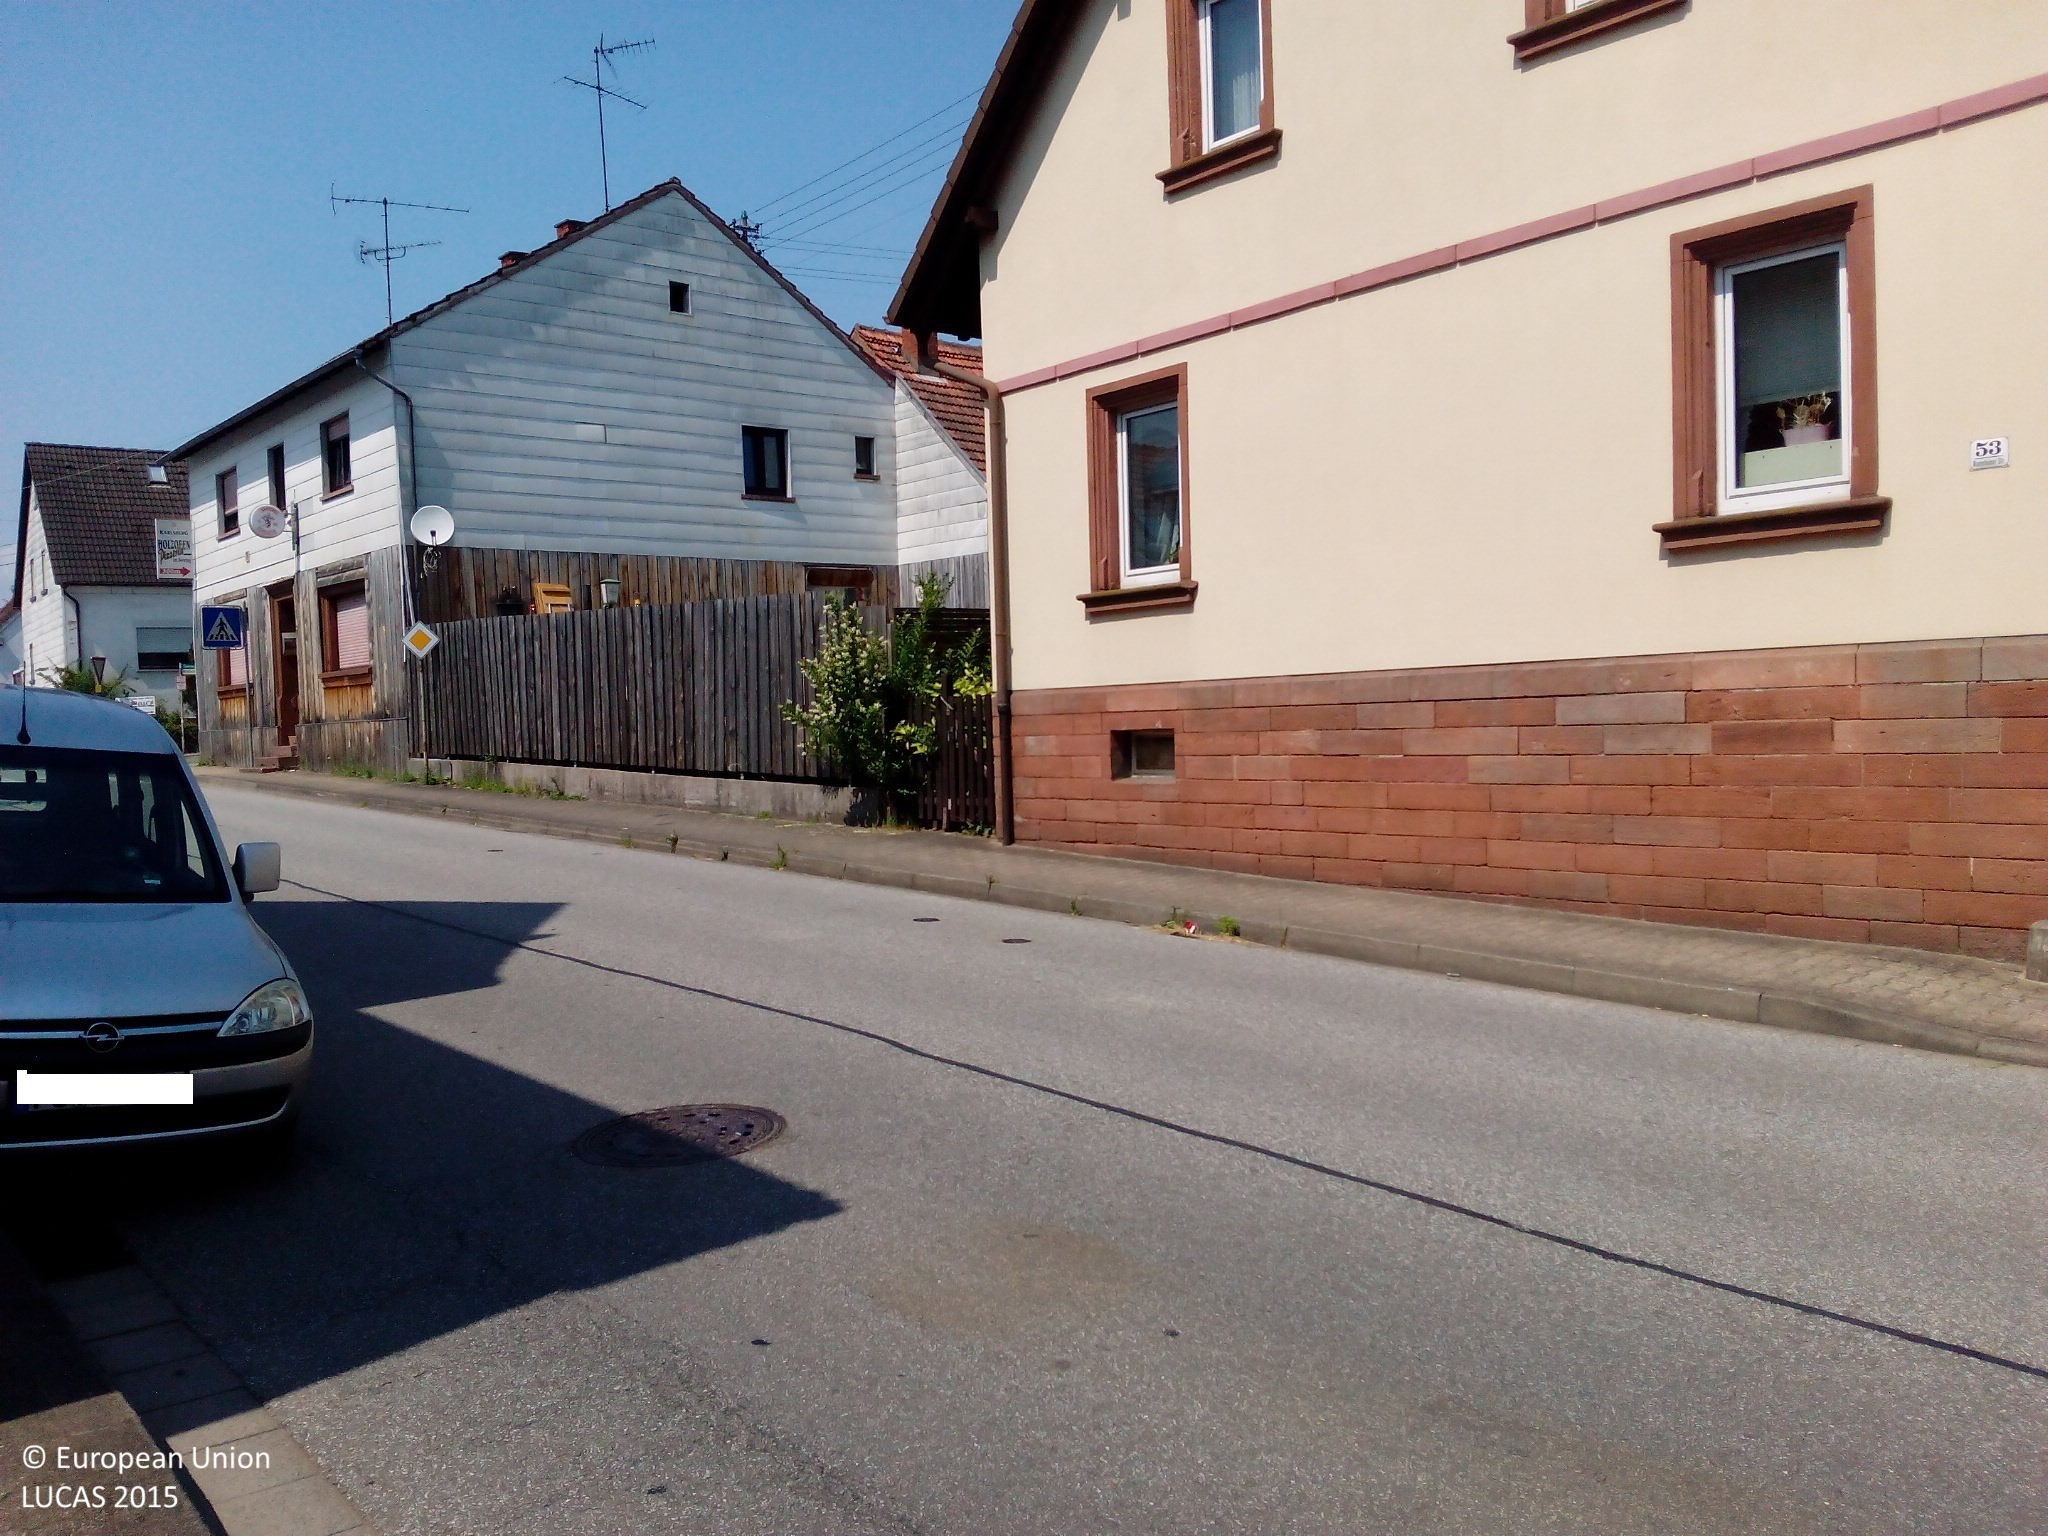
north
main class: Shrubland
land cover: Shrubland without tree cover
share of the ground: > 75 %
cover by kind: herbaceous plants 70 %, shrubs 20 %, unconsolidated bare surface 10 %
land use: Residential
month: July
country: DE
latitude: 49.4564
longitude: 7.5586
